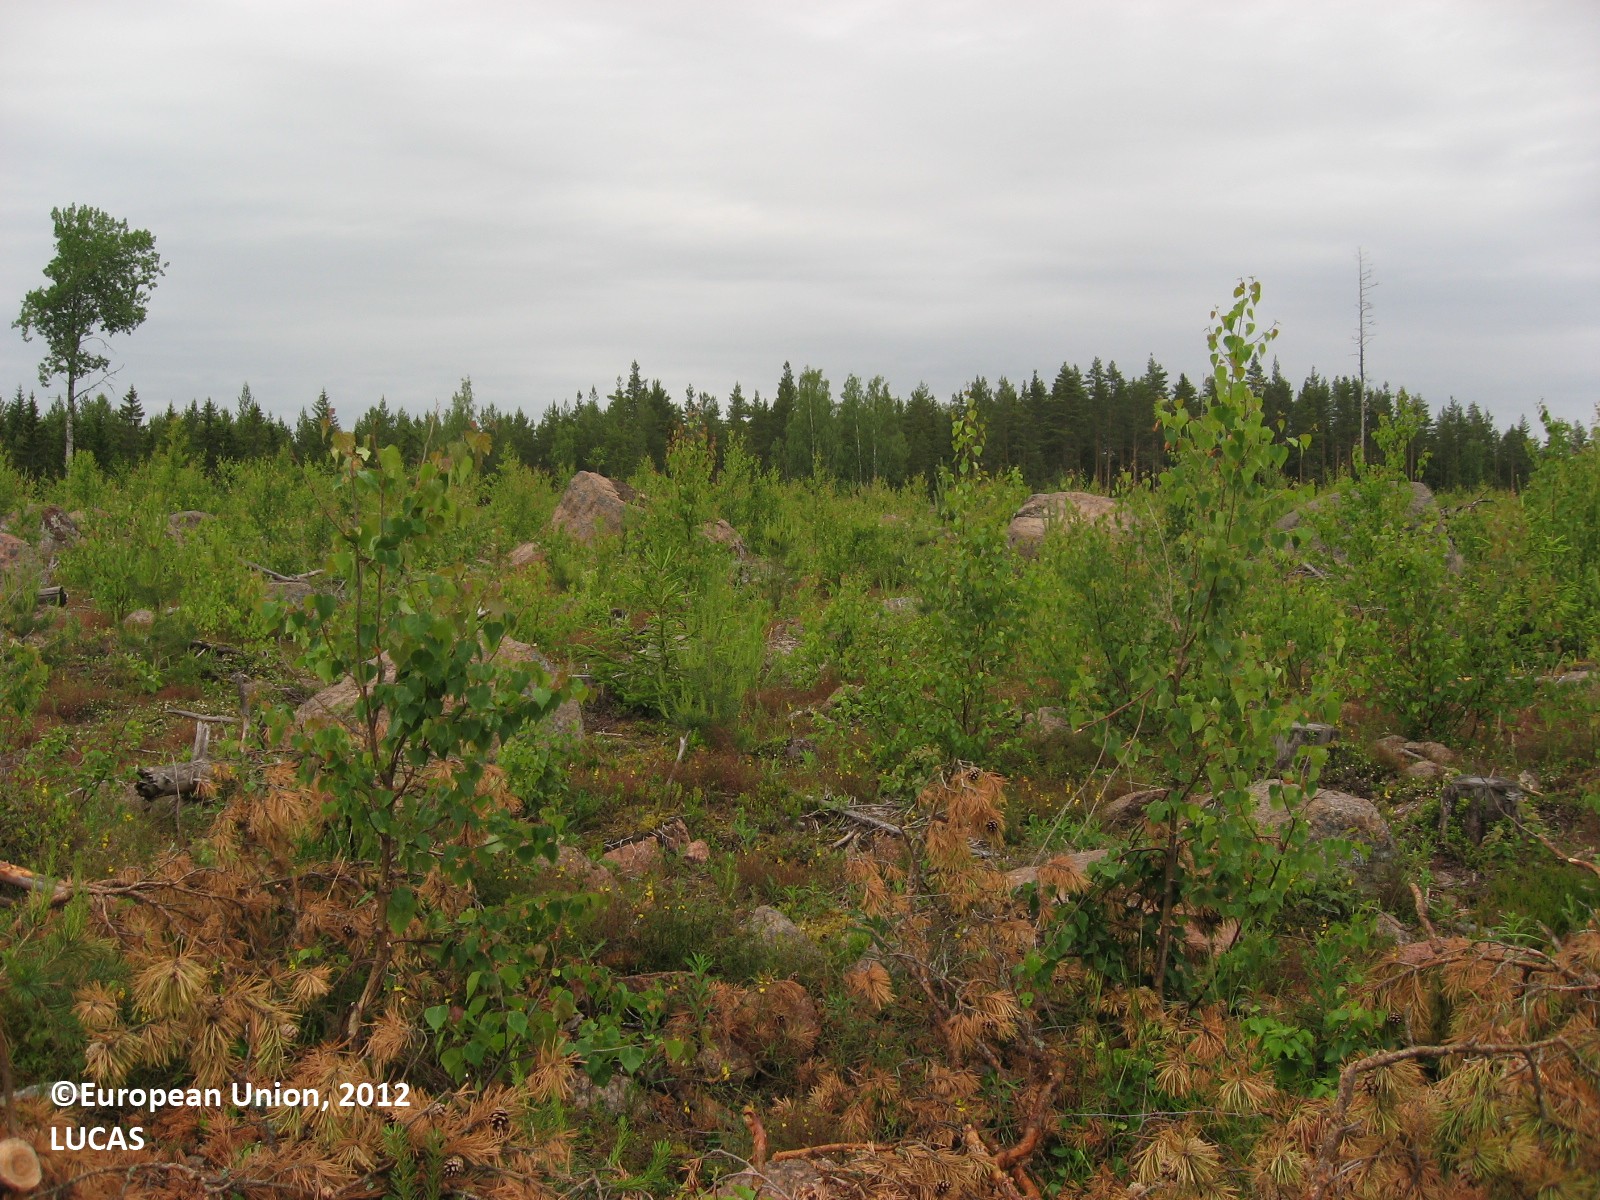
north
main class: Woodland
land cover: Pine dominated mixed woodland
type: boreal forest
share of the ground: 10 - 25 %
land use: Forestry
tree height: < 5 m
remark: Clear cut
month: June
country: FI
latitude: 60.4219
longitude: 26.2968
